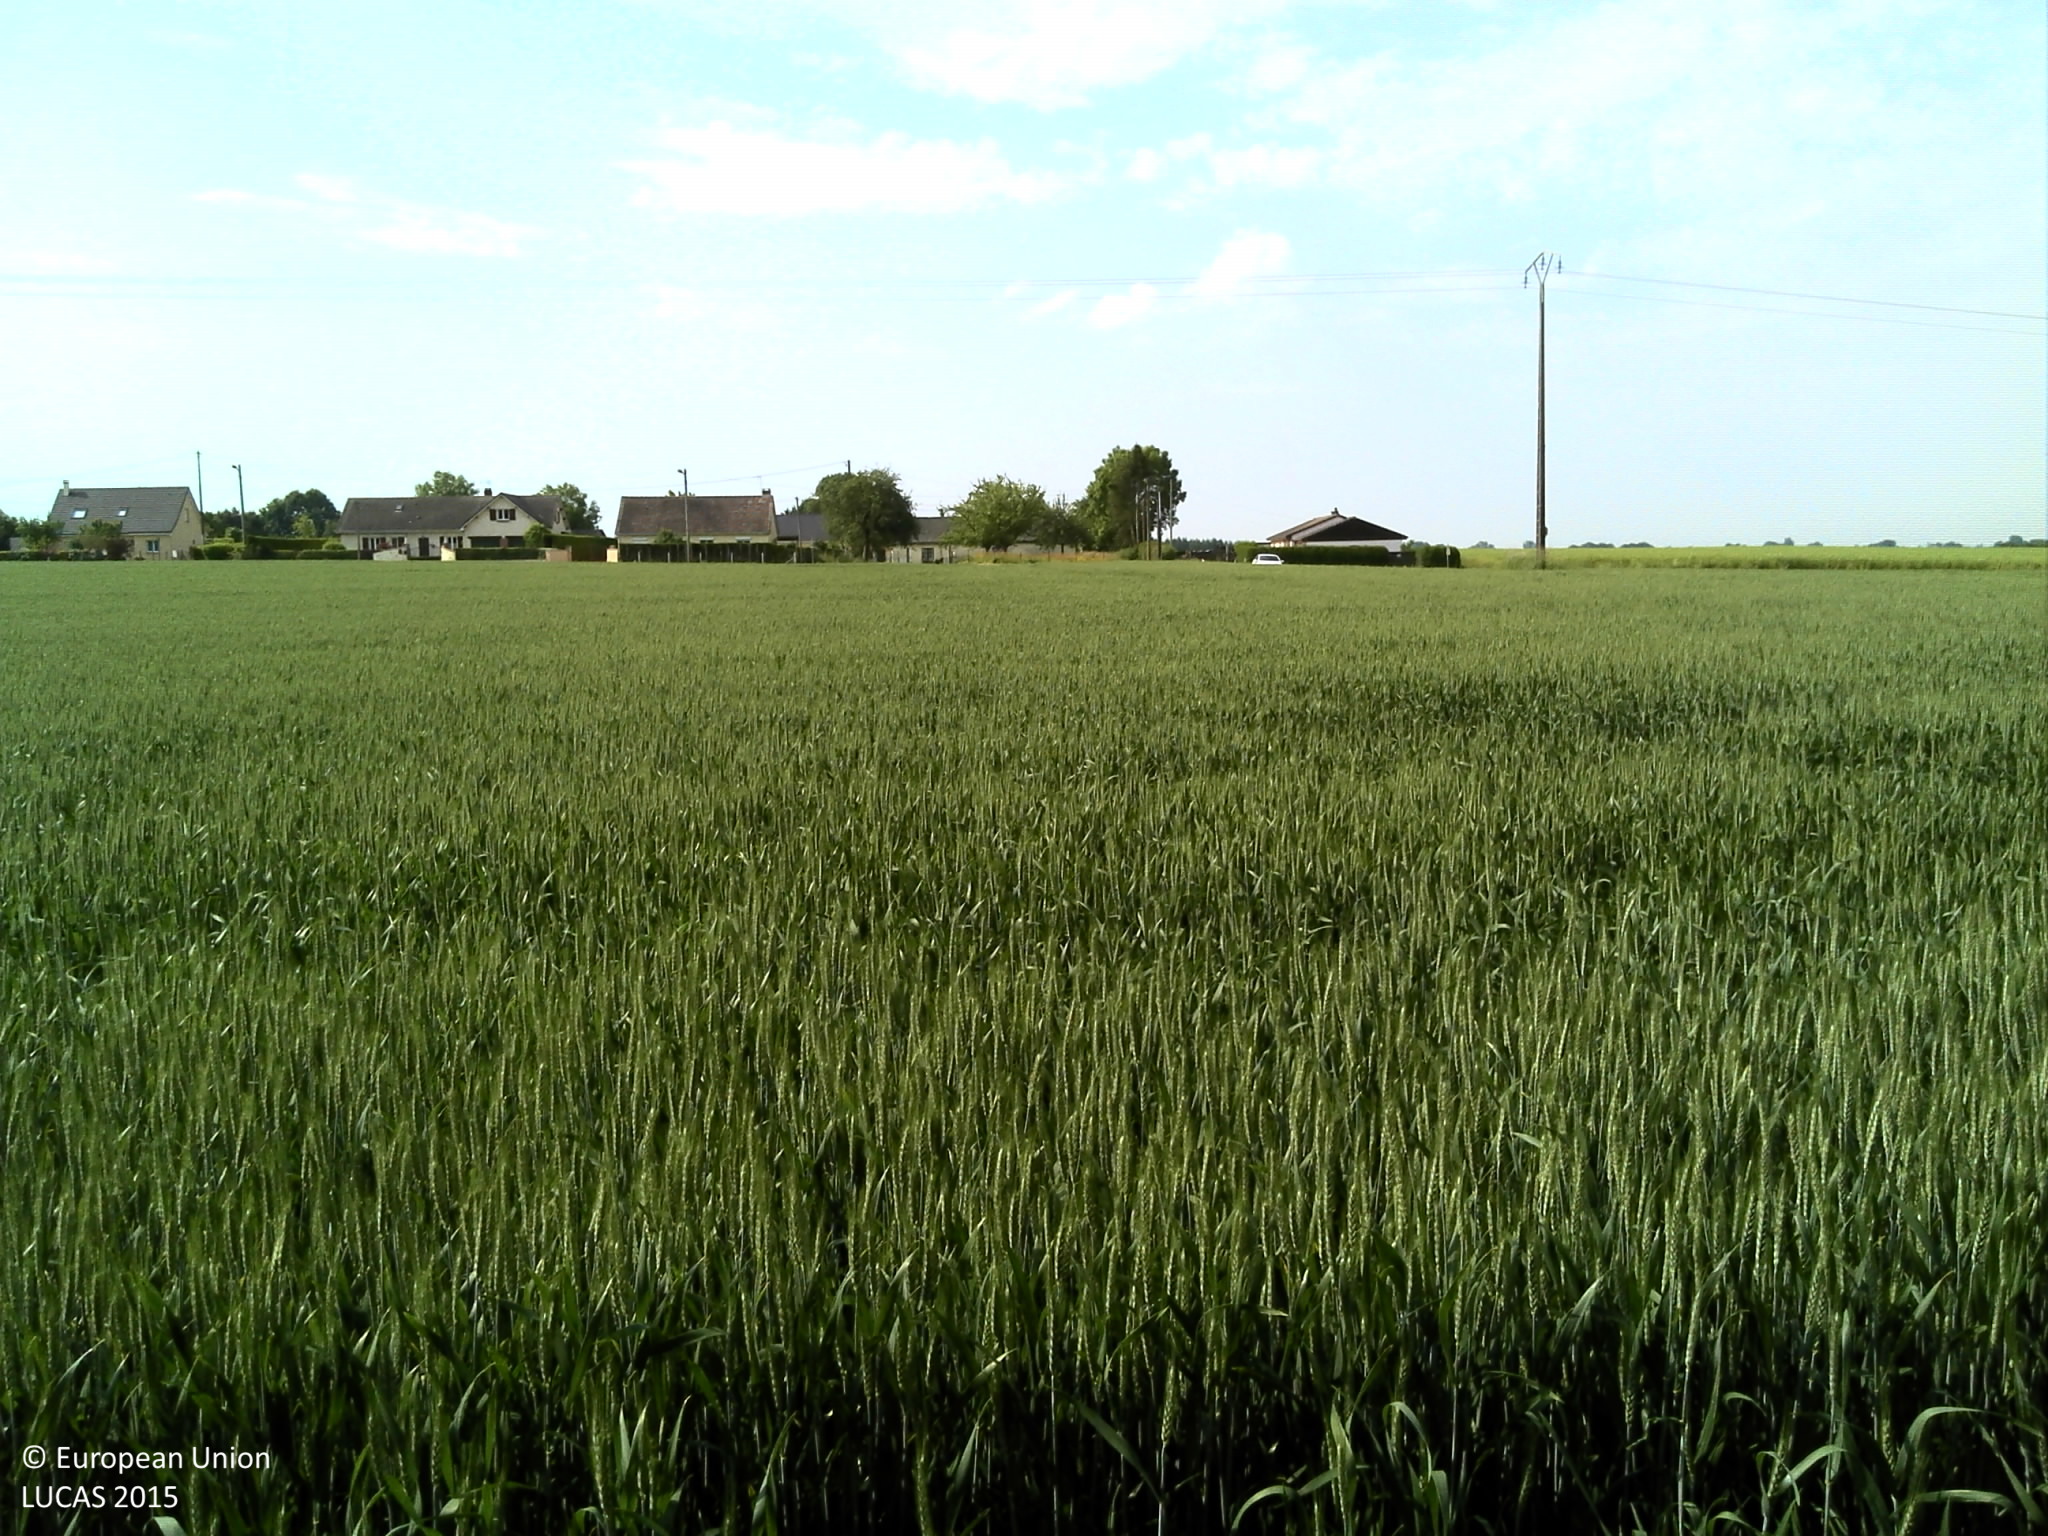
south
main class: Cropland
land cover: Common wheat
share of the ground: > 75 %
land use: Agriculture (excluding fallow land and kitchen gardens)
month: June
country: FR
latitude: 49.7482
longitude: 1.1379
